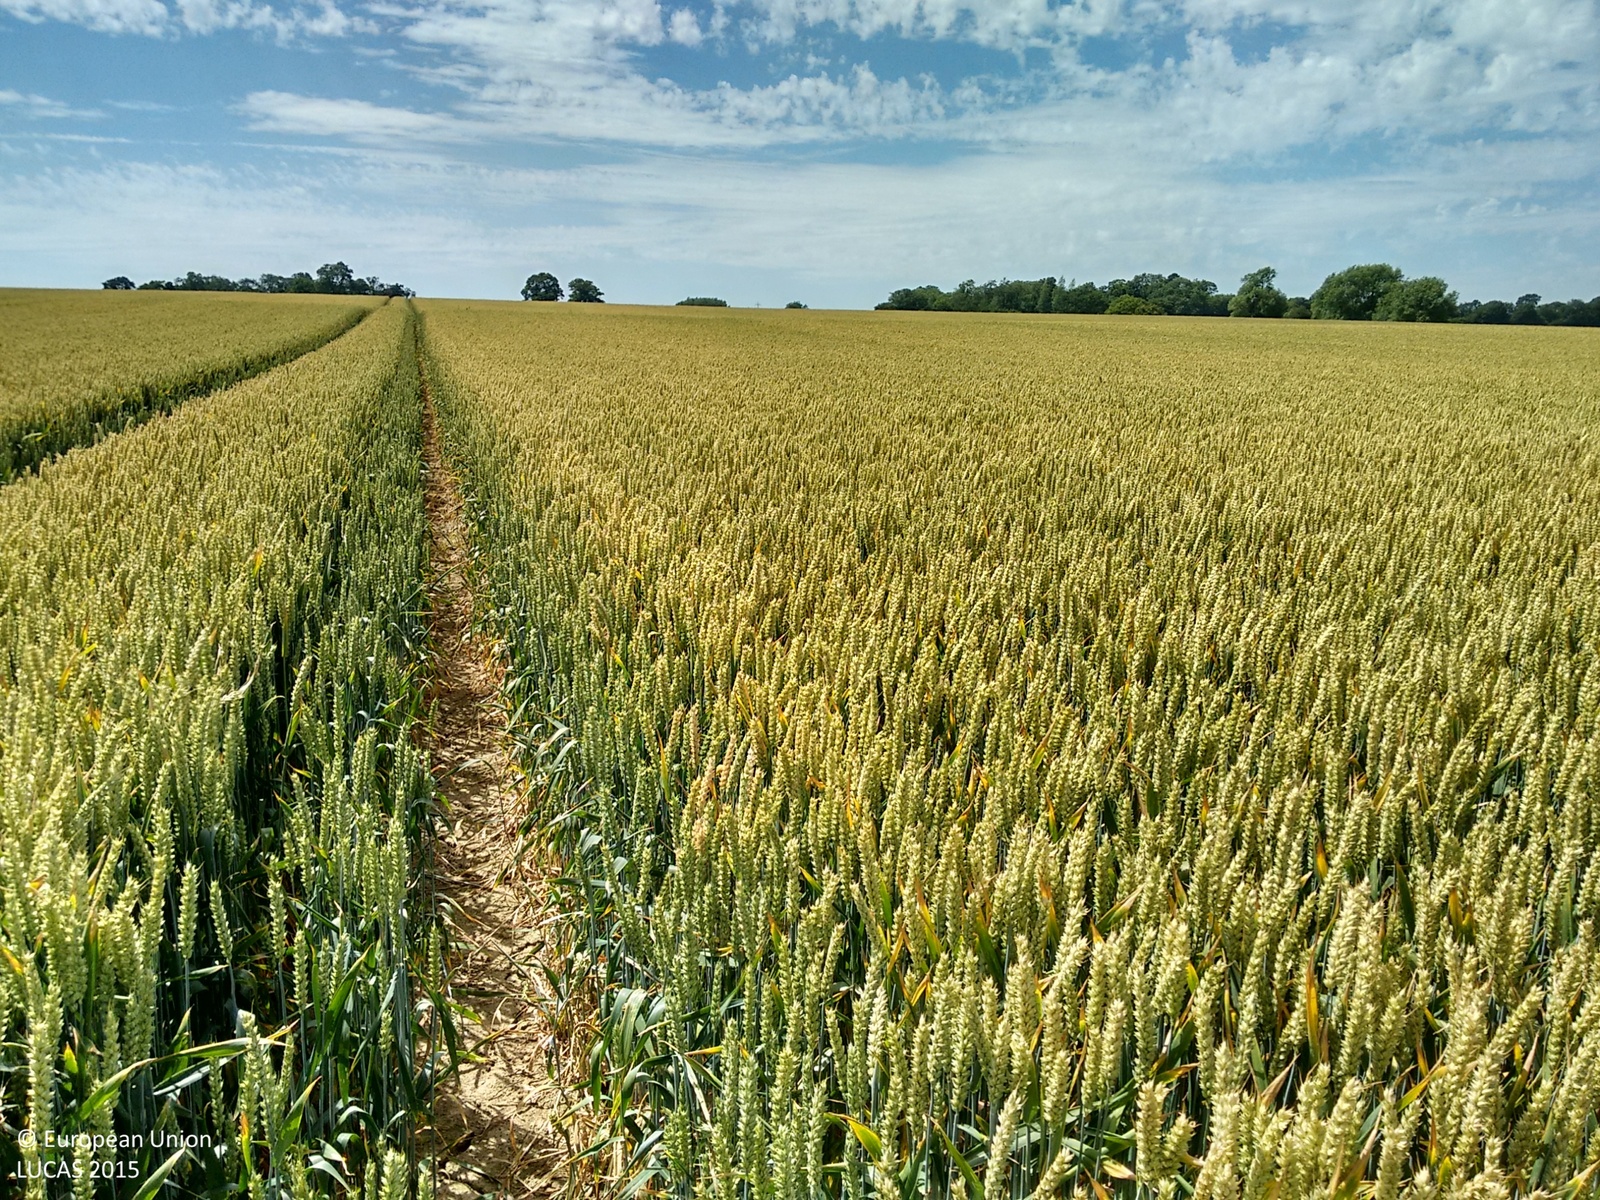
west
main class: Cropland
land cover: Common wheat
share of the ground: > 75 %
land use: Agriculture (excluding fallow land and kitchen gardens)
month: July
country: GB
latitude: 51.6851
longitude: -1.1697
